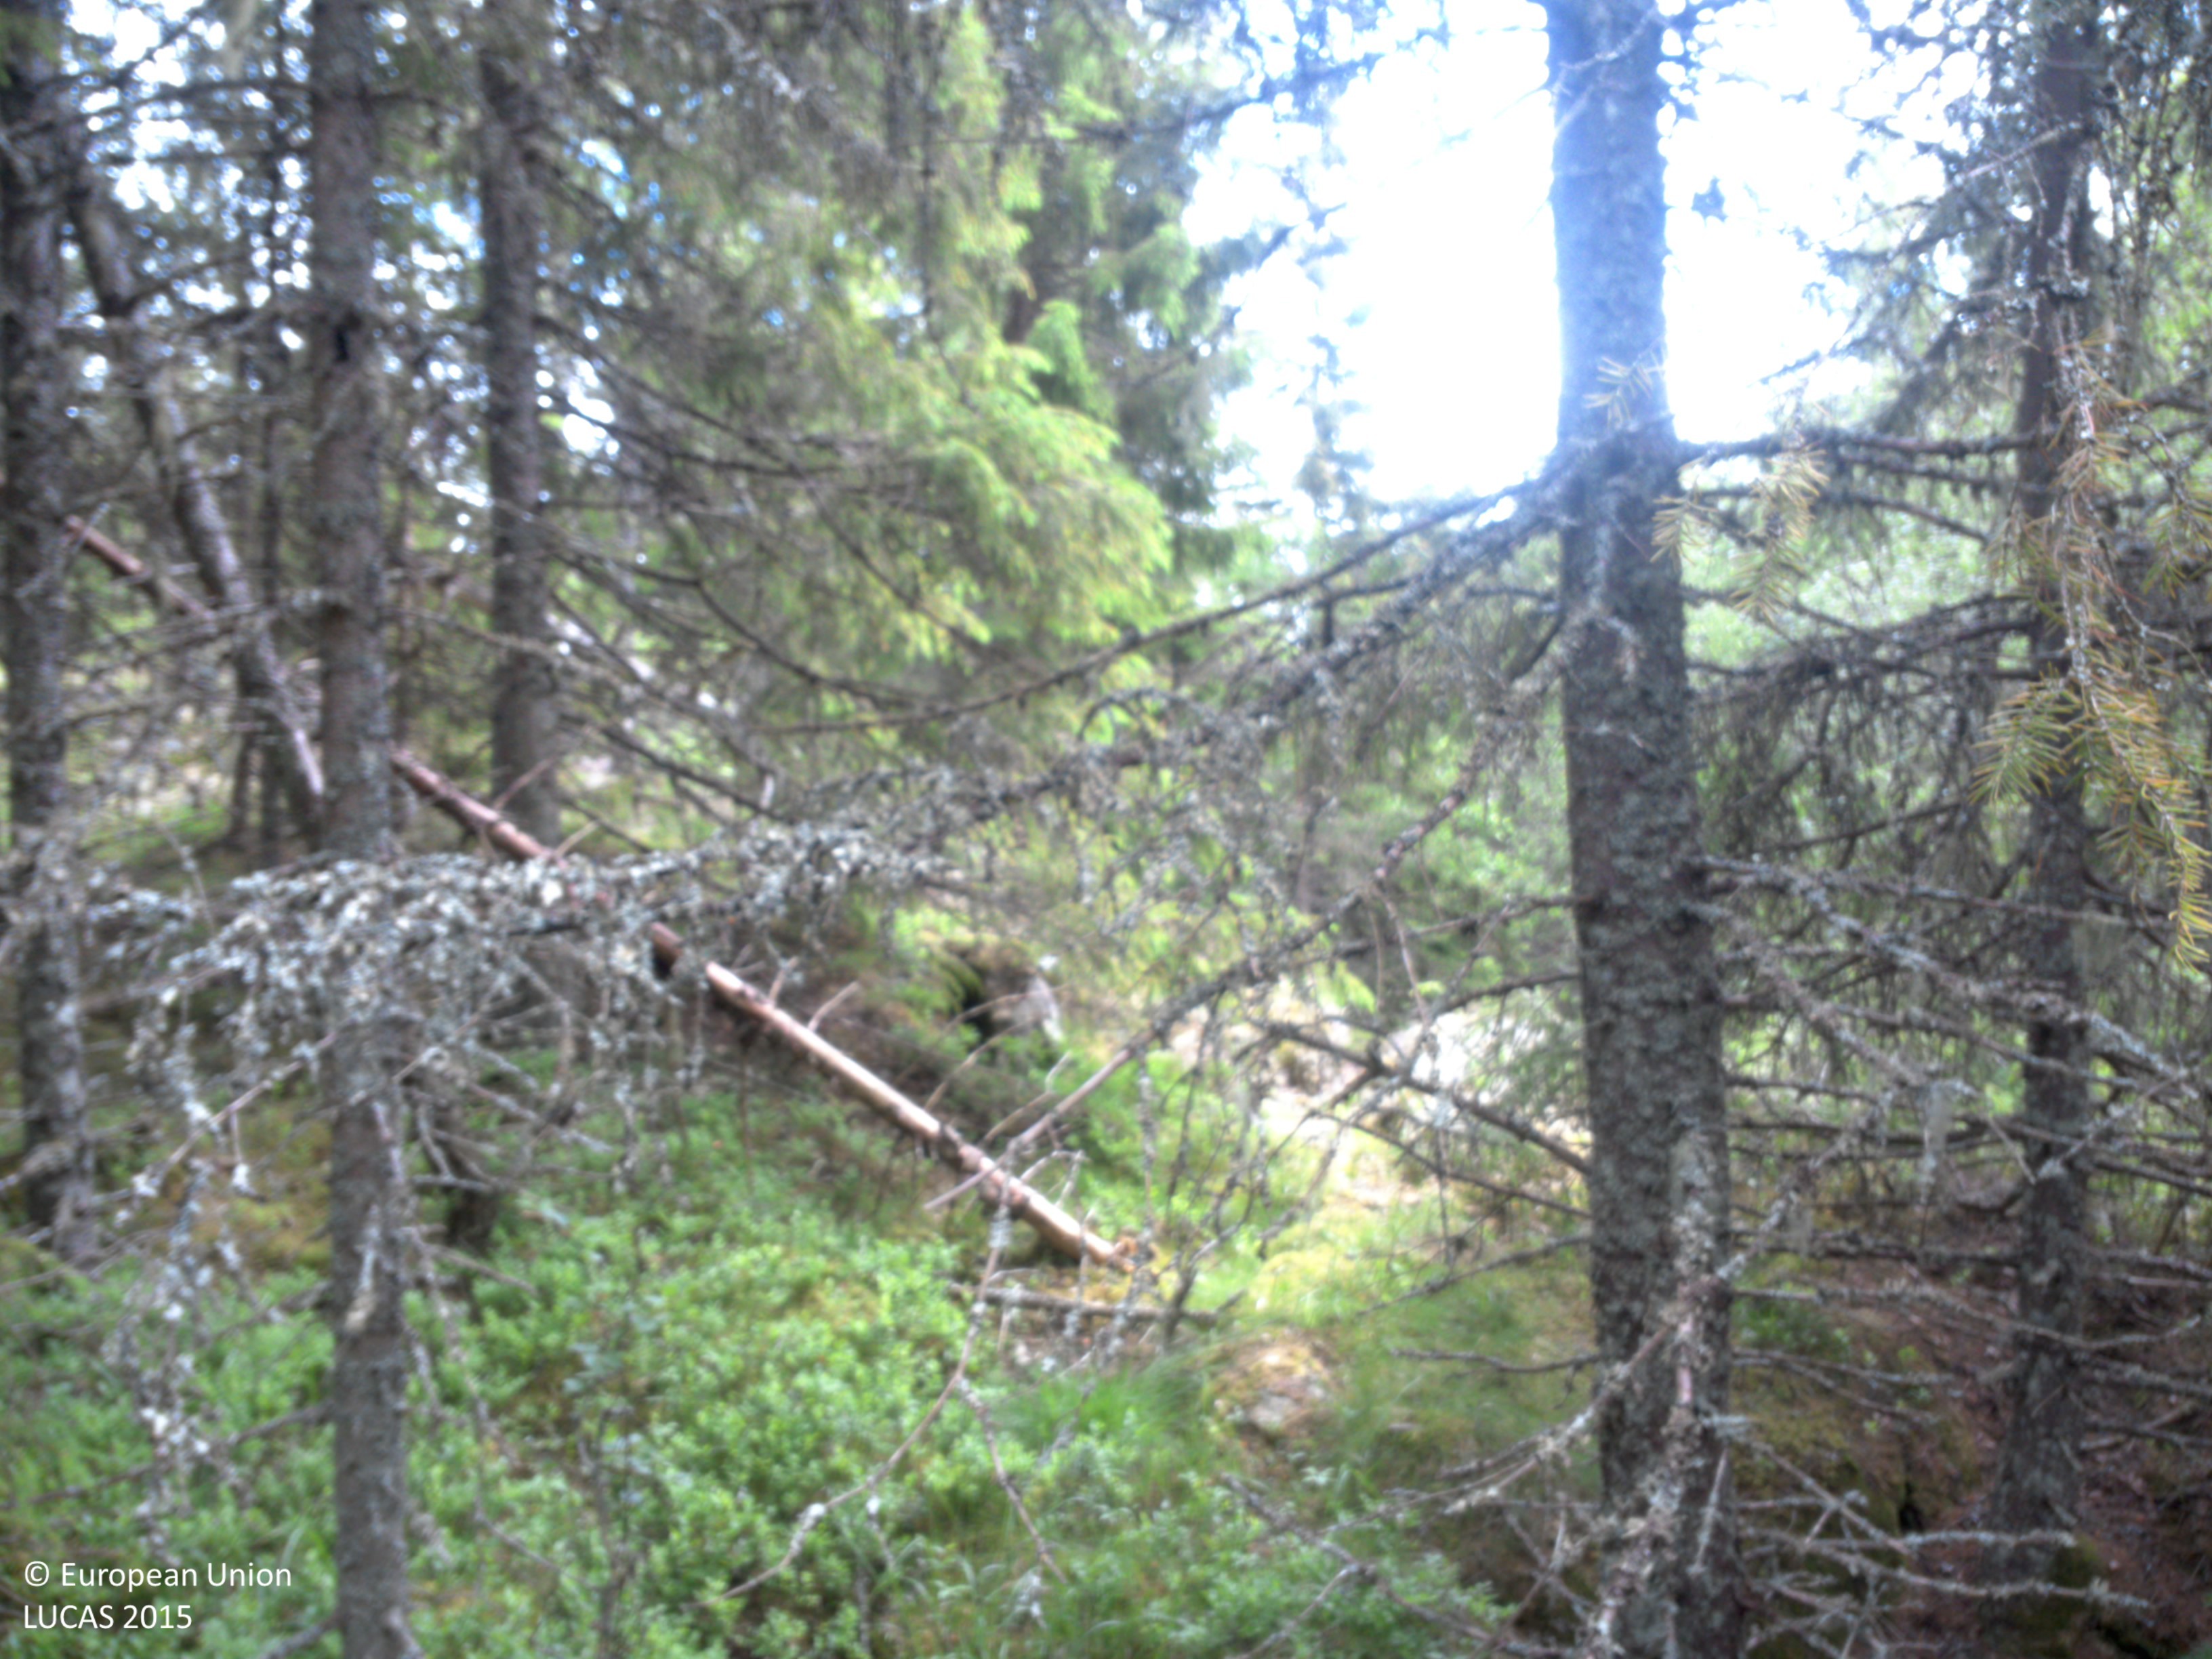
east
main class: Woodland
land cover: Spruce dominated coniferous woodland
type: boreal forest
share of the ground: 50 - 75 %
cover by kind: coniferous forest trees 60 %, lichens and mosses 35 %, broadleaved forest trees 5 %
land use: Forestry
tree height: > 5 m
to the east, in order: Spruce dominated coniferous woodland; Rock outcrops; Spruce dominated coniferous woodland; Rivers and streams; Spruce dominated coniferous woodland
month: June
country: SE
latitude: 59.0138
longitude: 12.0327
